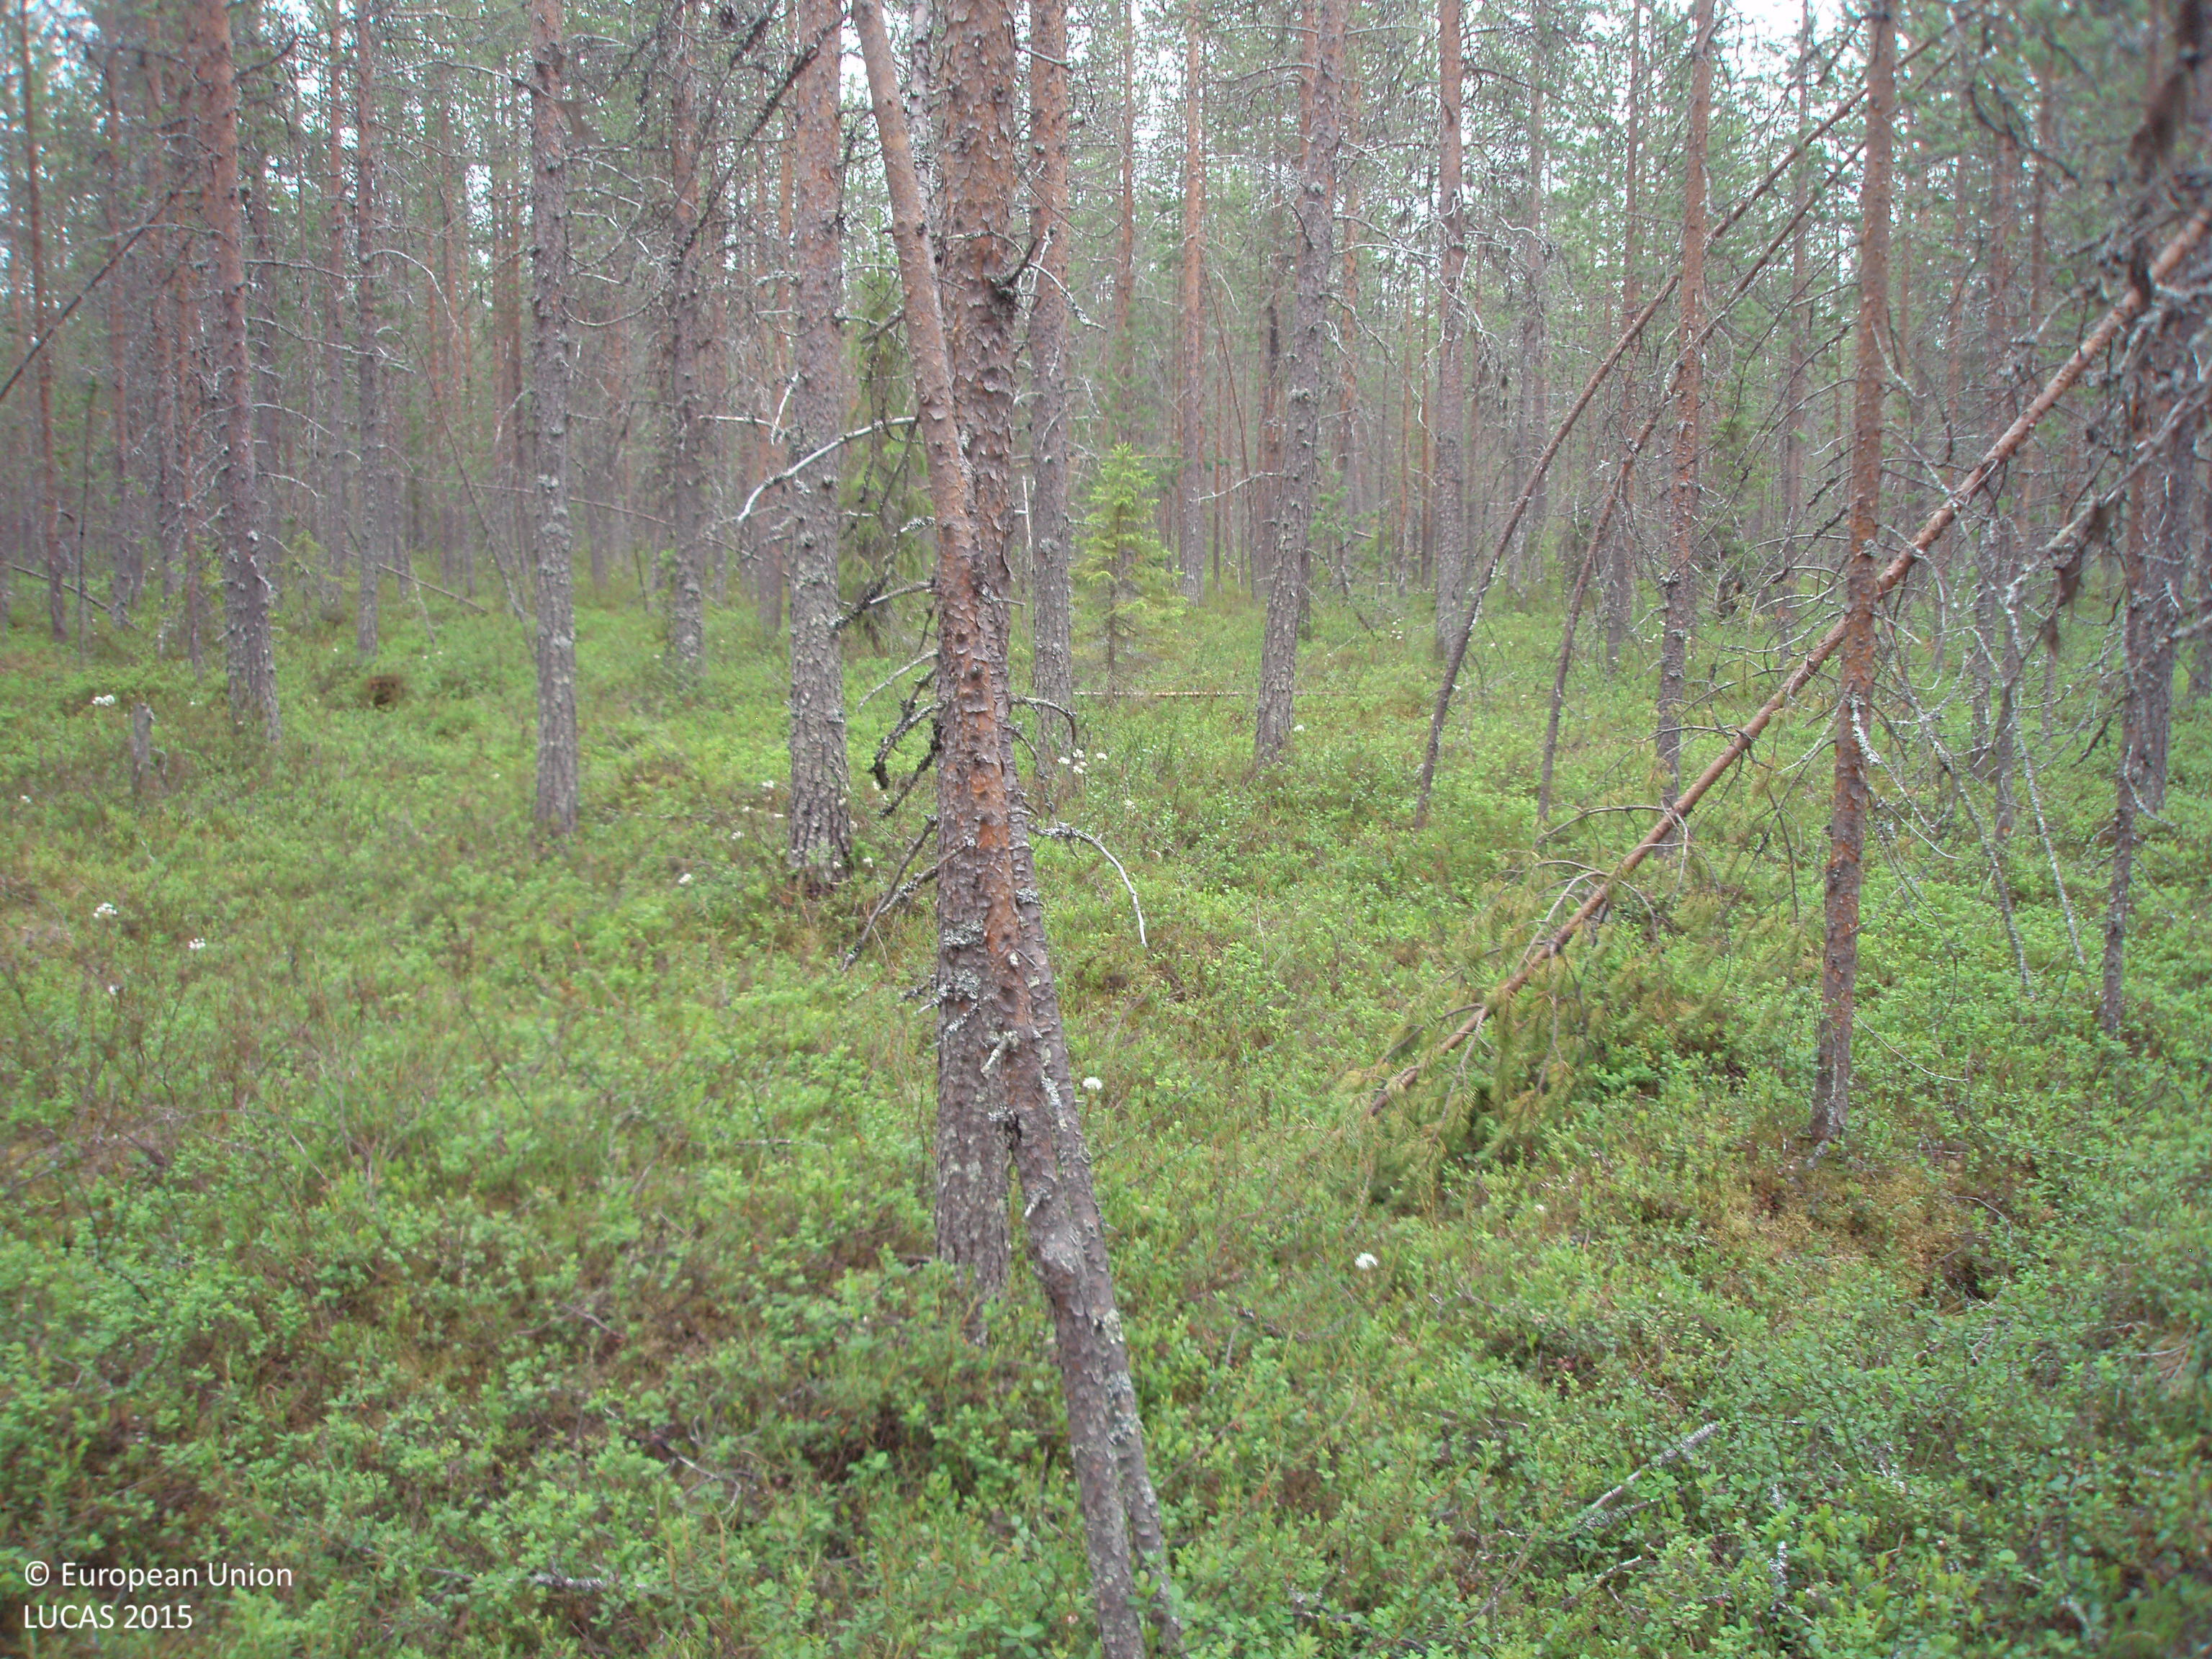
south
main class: Woodland
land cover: Pine dominated coniferous woodland
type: boreal forest
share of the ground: > 75 %
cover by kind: coniferous forest trees 75 %, shrubs 25 %
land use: Forestry
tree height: > 5 m
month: July
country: FI
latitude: 67.5615
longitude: 28.5104
